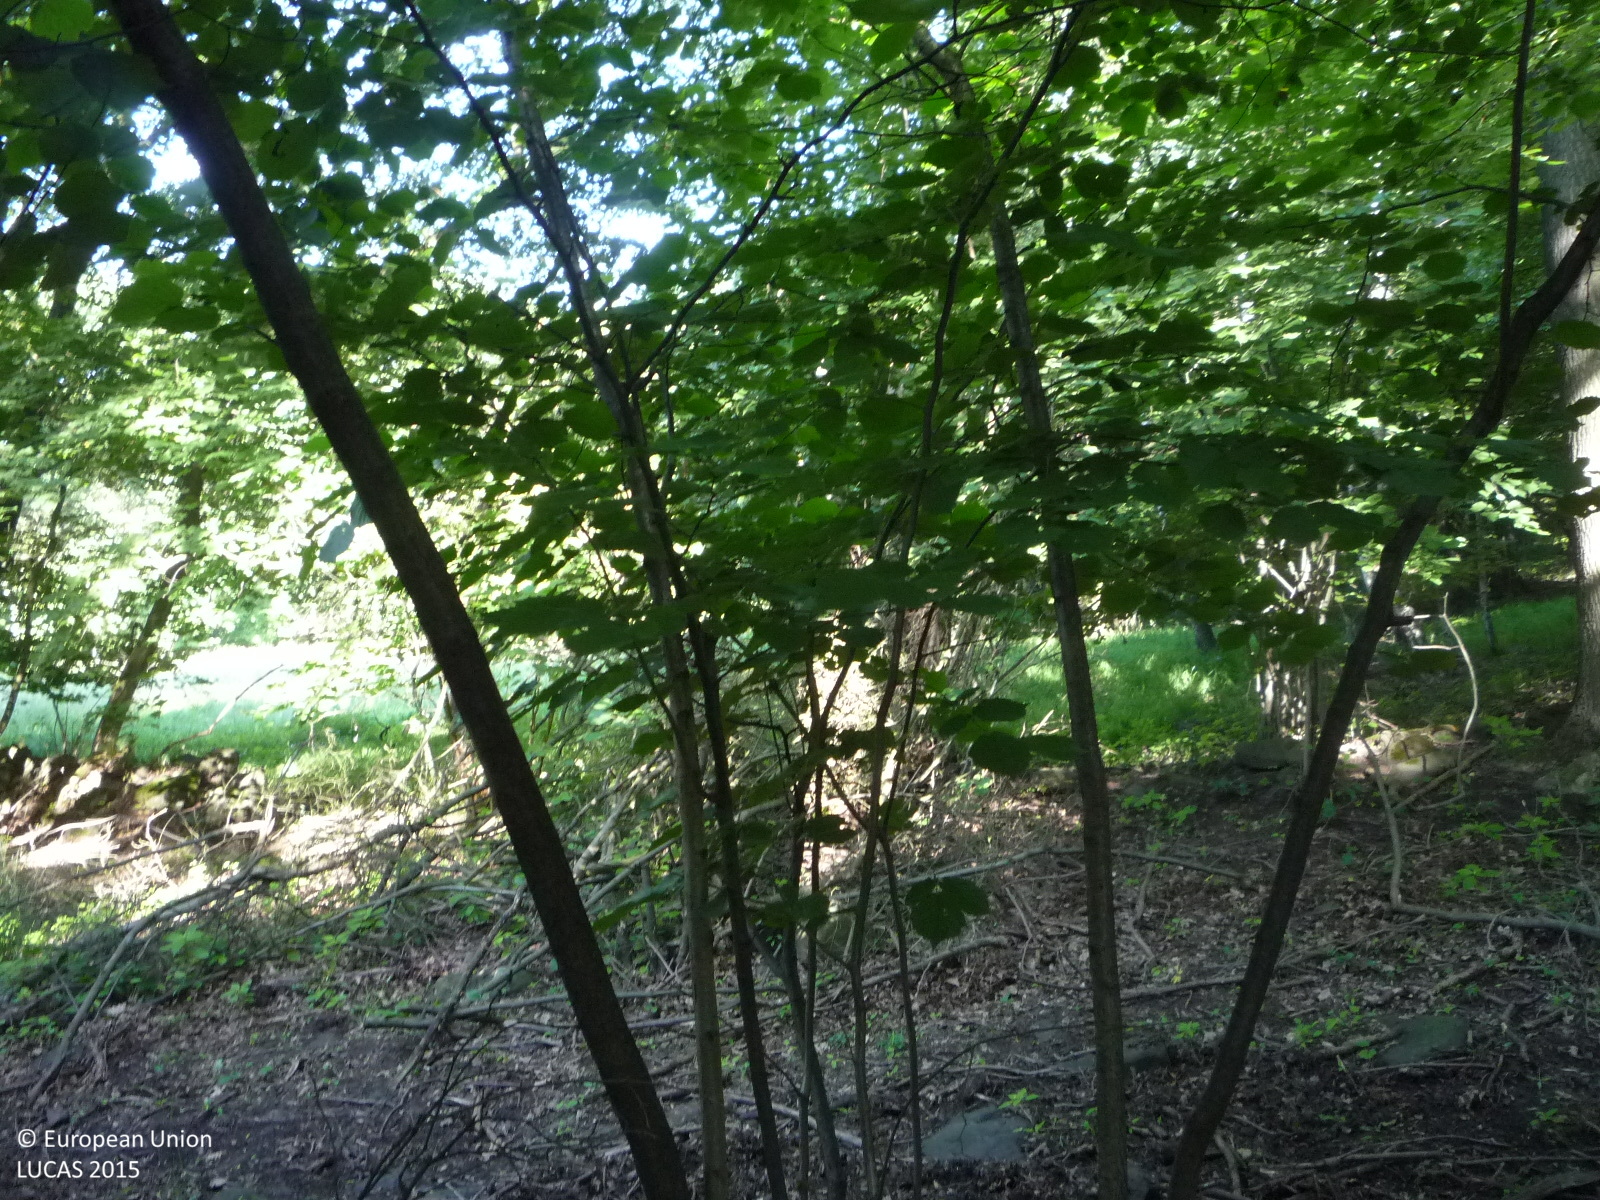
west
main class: Woodland
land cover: Broadleaved woodland
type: mesophytic deciduous forest
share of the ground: > 75 %
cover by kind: broadleaved forest trees 95 %, shrubs 5 %
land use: Forestry
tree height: > 5 m
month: July
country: CZ
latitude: 50.5323
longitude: 13.8805
